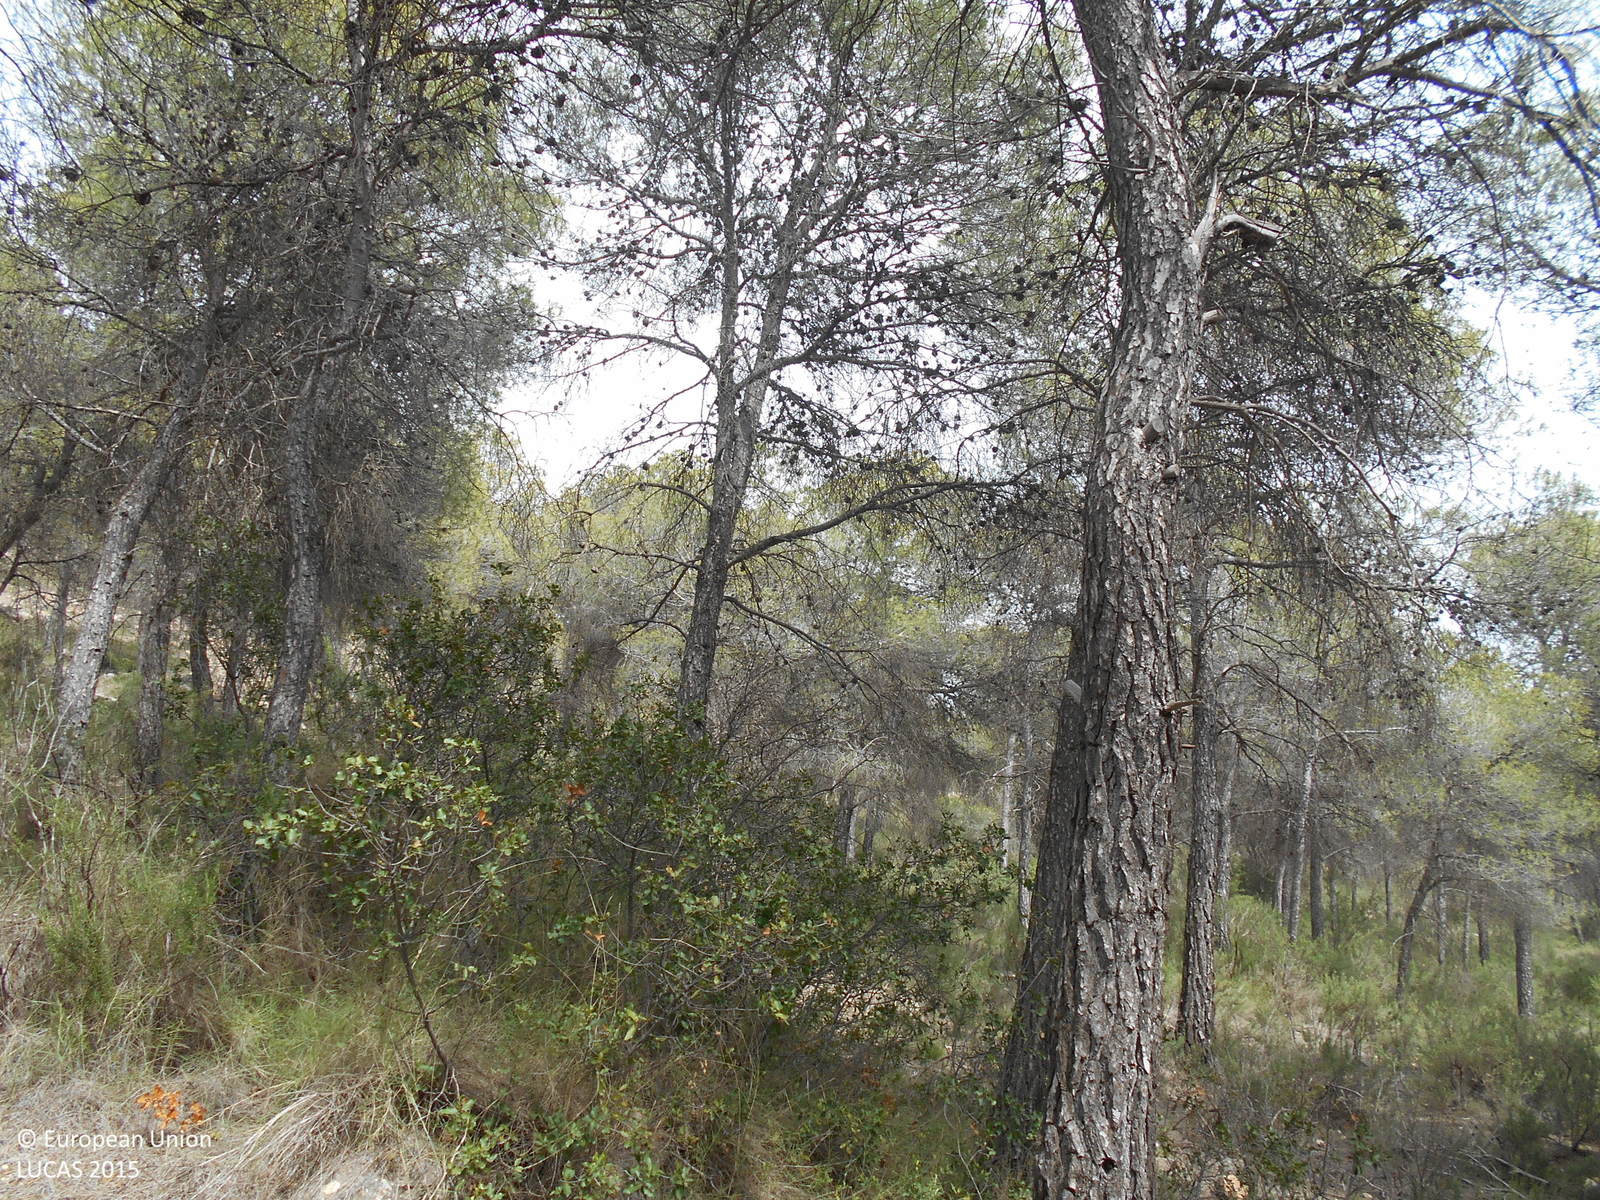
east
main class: Woodland
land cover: Pine dominated coniferous woodland
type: coniferous forest of the mediterranean region
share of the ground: > 75 %
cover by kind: coniferous forest trees 75 %, shrubs 20 %, unconsolidated bare surface 5 %
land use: Semi-natural and natural areas not in use
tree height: > 5 m
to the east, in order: Pine dominated coniferous woodland; Shrubland without tree cover; Pine dominated coniferous woodland
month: April
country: ES
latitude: 37.8708
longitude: -1.5000
